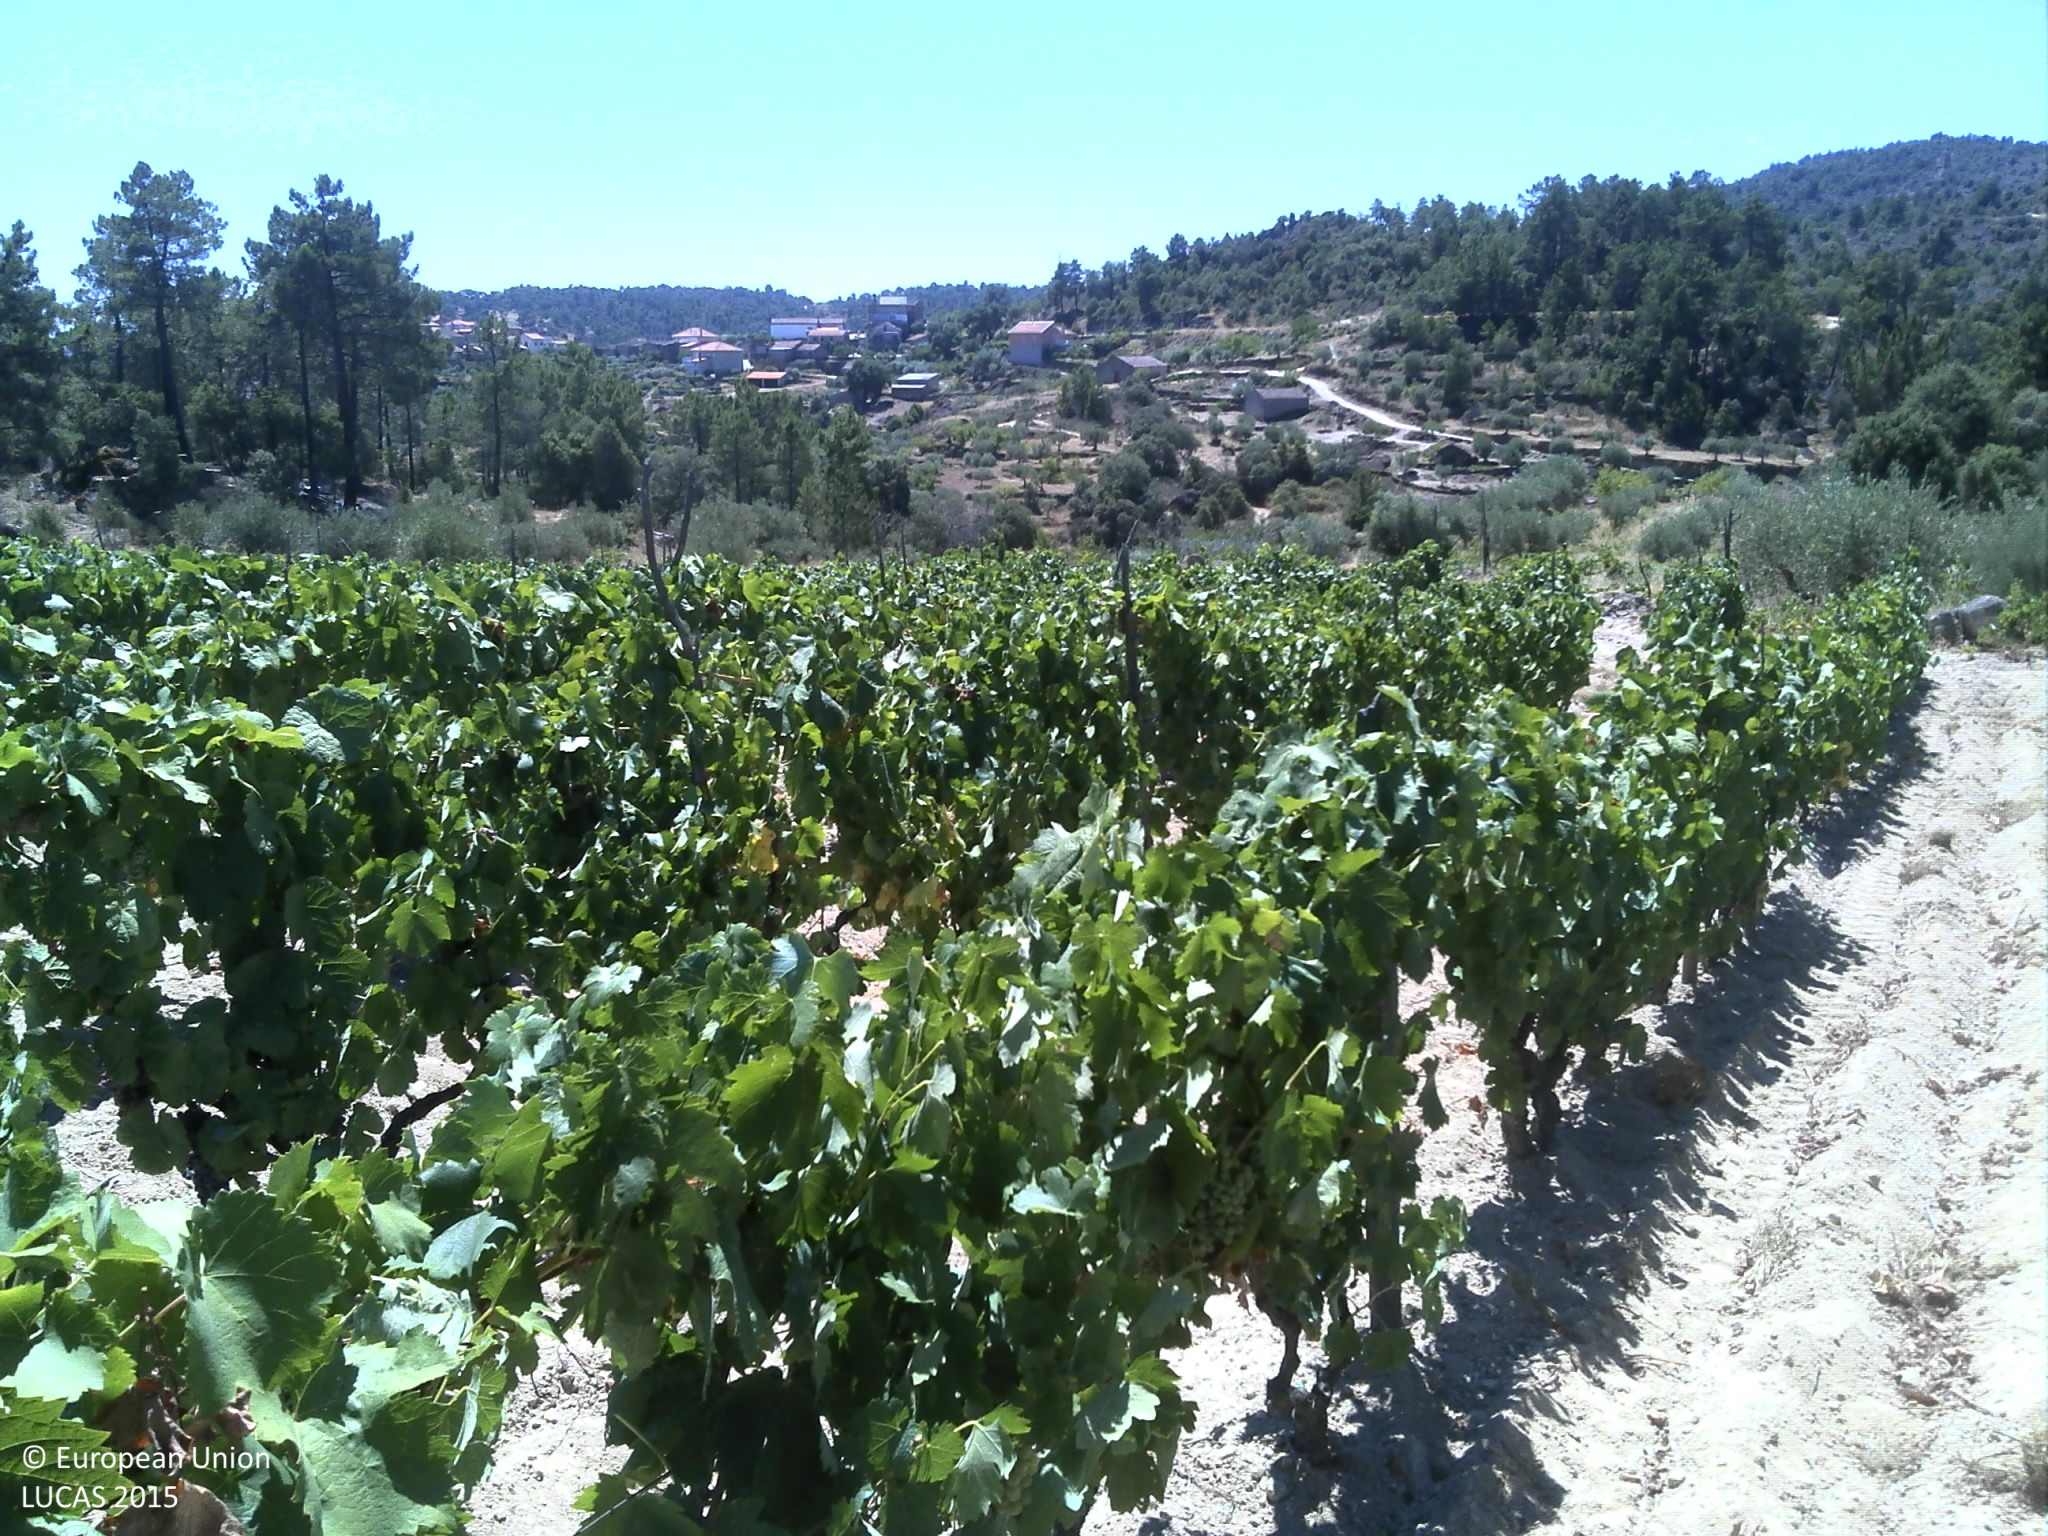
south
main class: Cropland
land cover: Vineyards
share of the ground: 10 - 25 %
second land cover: Other bare soil
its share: > 75 %
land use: Agriculture (excluding fallow land and kitchen gardens)
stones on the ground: 25 - 50 %
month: July
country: PT
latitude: 41.1963
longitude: -7.1529
